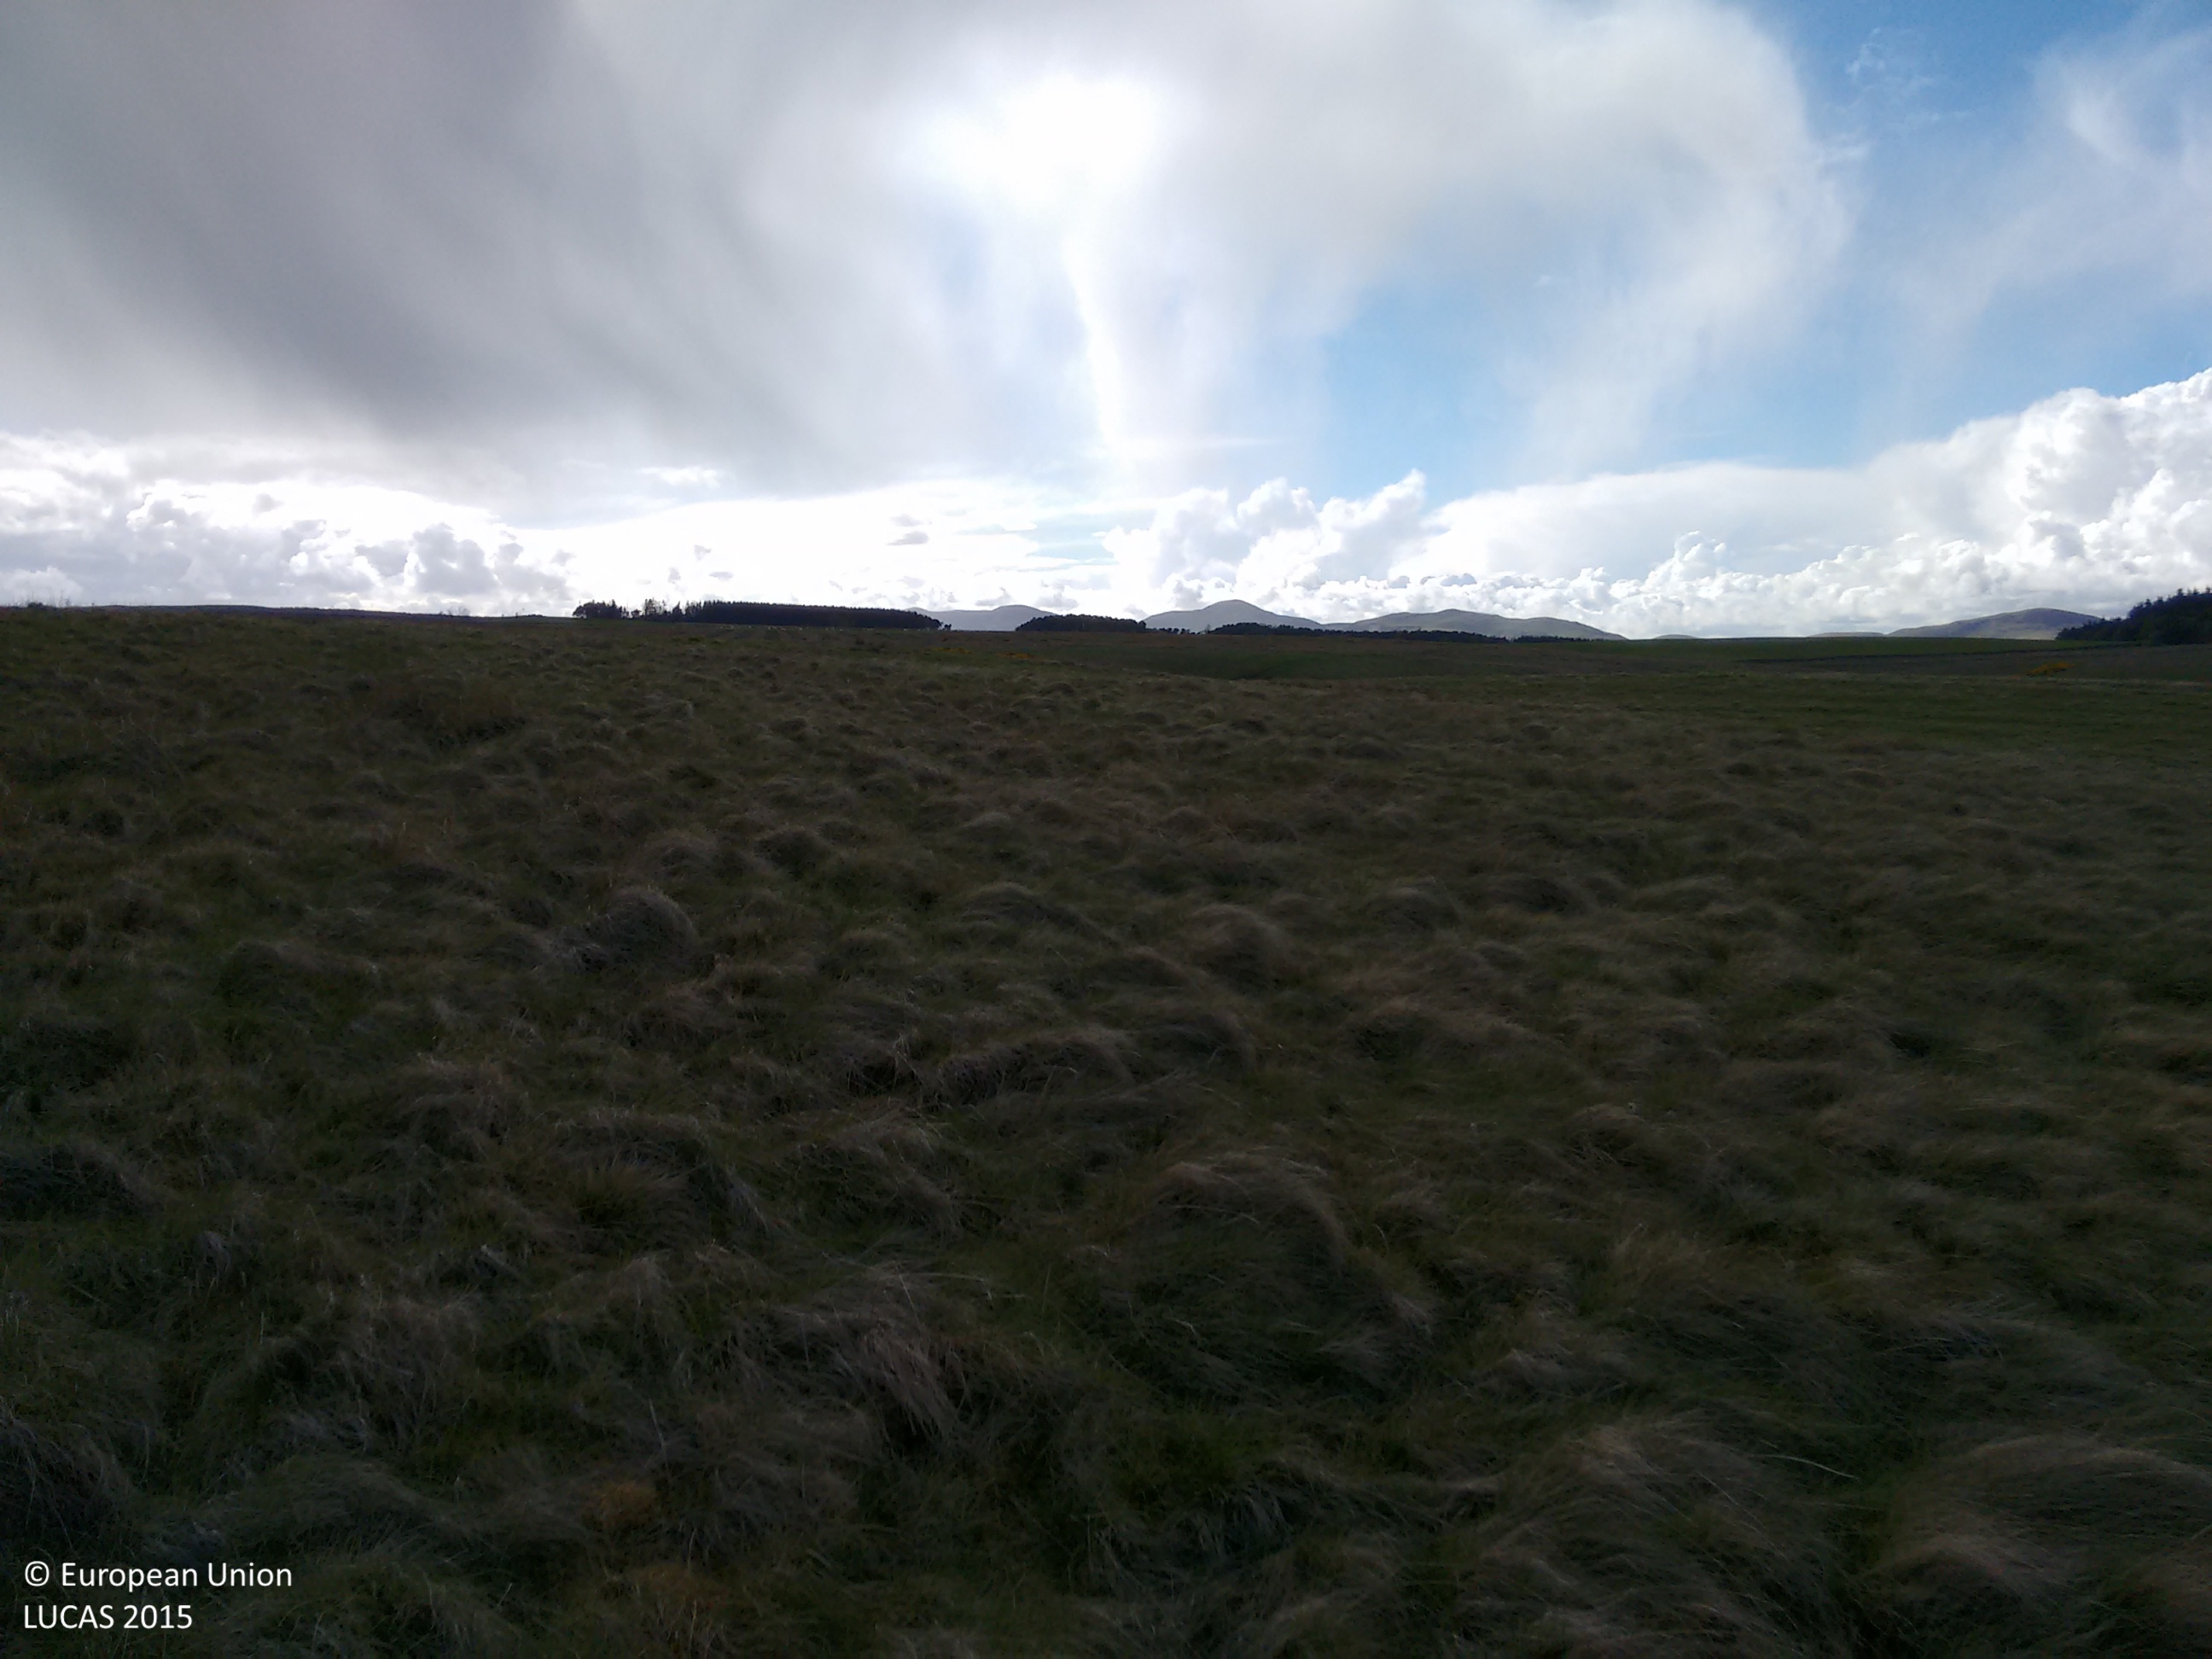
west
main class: Grassland
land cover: Grassland without tree/shrub cover
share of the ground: > 75 %
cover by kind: herbaceous plants 100 %
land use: Agriculture (excluding fallow land and kitchen gardens)
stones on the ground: < 10 %
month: May
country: GB
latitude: 55.8181
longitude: -3.1422
